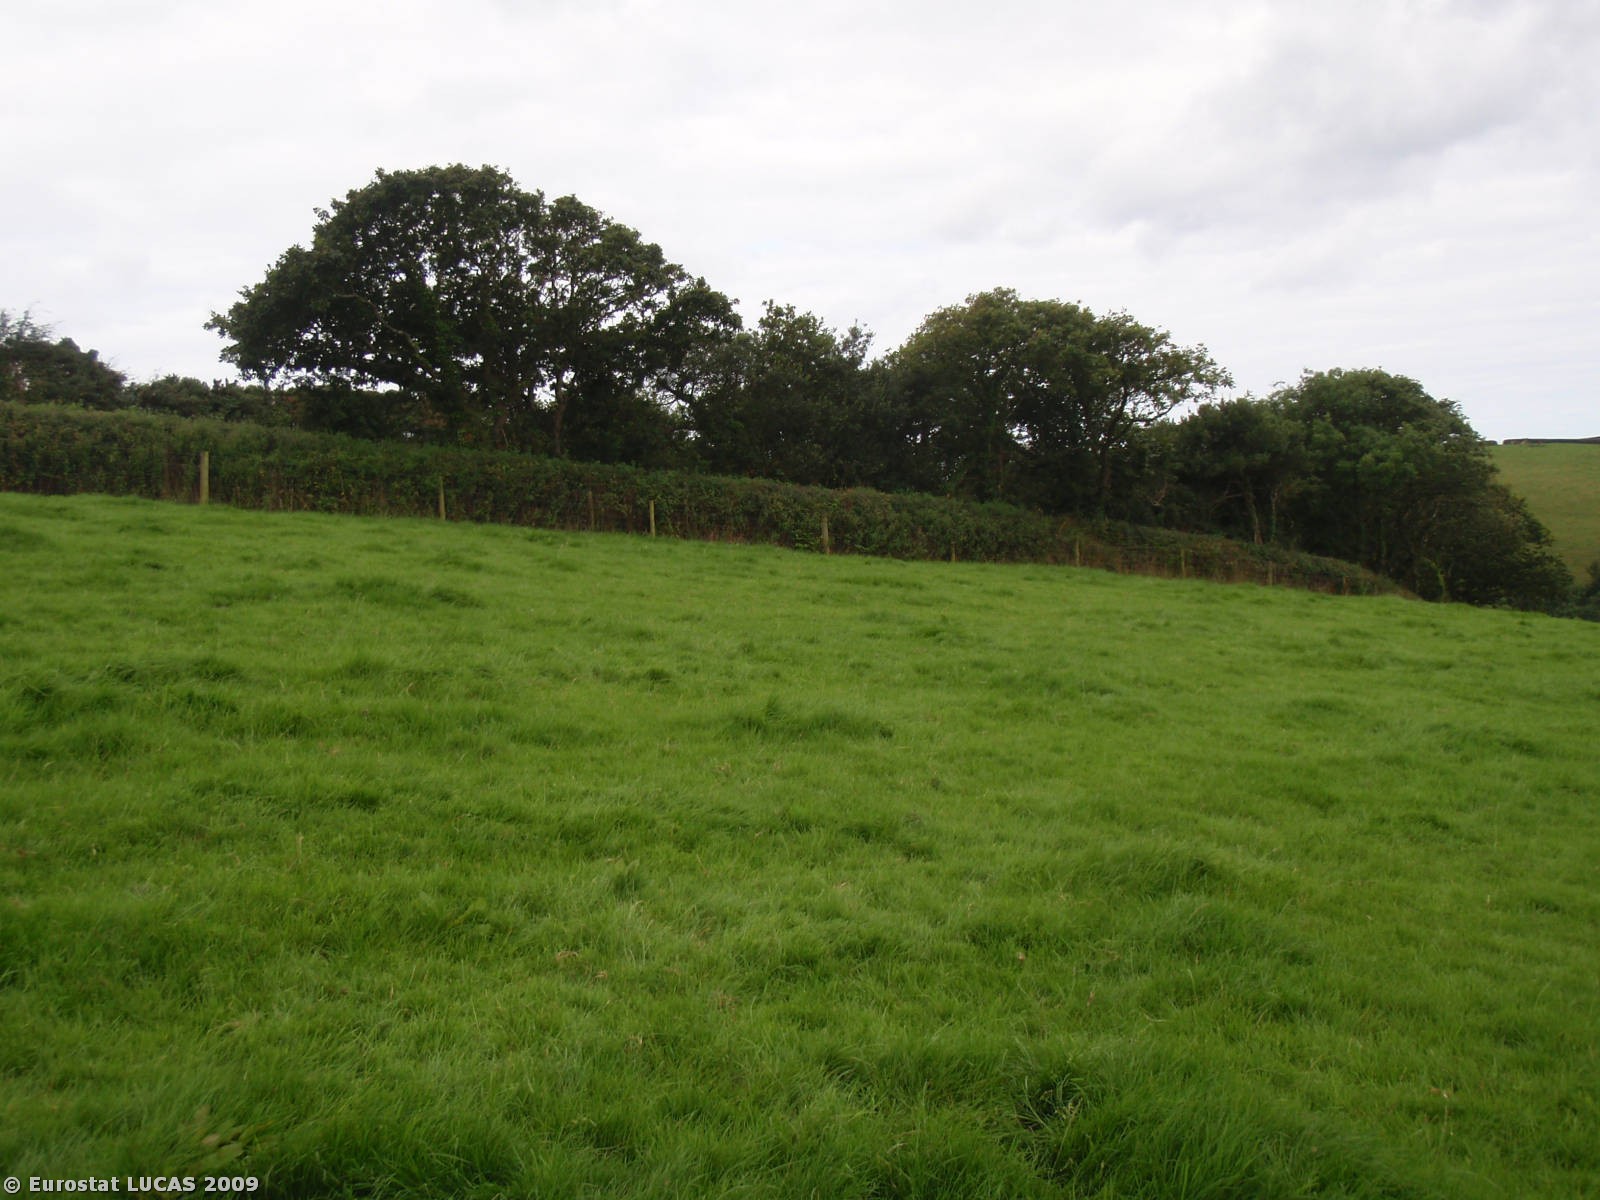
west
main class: Grassland
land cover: Grassland without tree/shrub cover
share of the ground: > 75 %
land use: Agriculture (excluding fallow land and kitchen gardens)
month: August
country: GB
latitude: 50.7365
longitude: -4.6023
